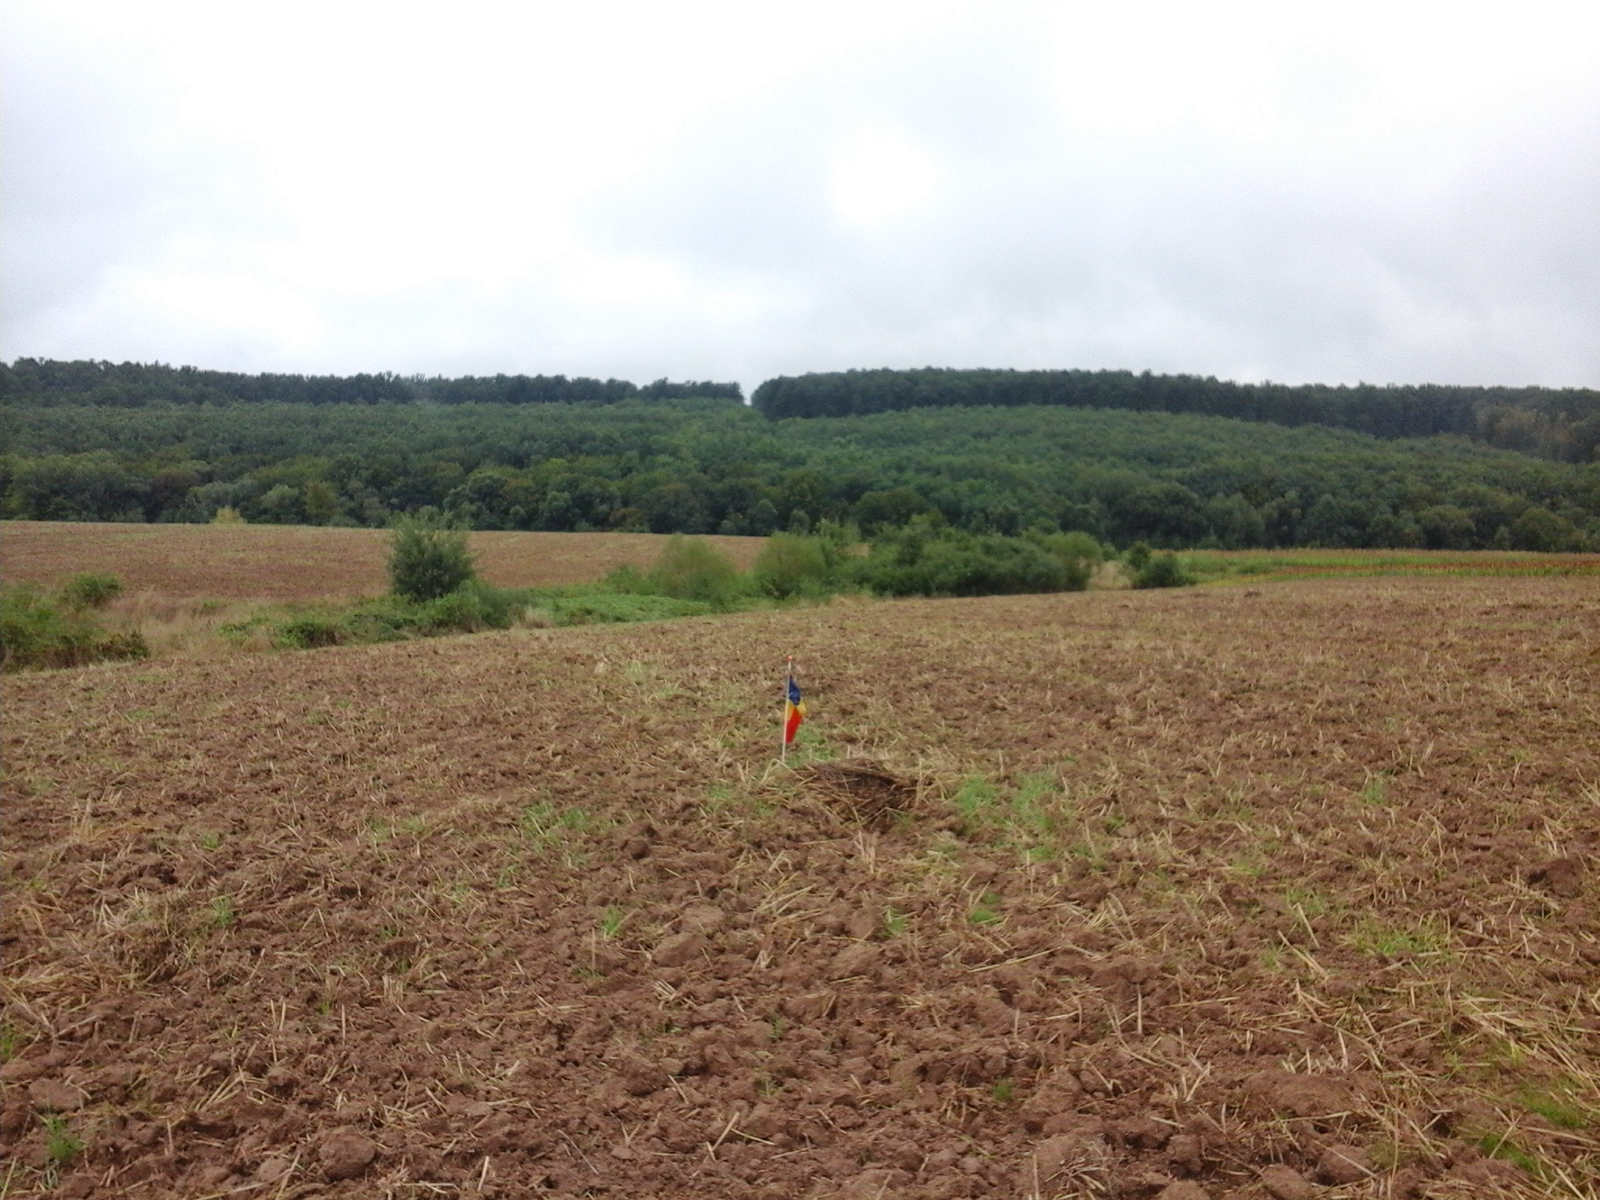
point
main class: Cropland
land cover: Common wheat
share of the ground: < 10 %
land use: Agriculture (excluding fallow land and kitchen gardens)
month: September
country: RO
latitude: 46.8060
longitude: 21.9568
